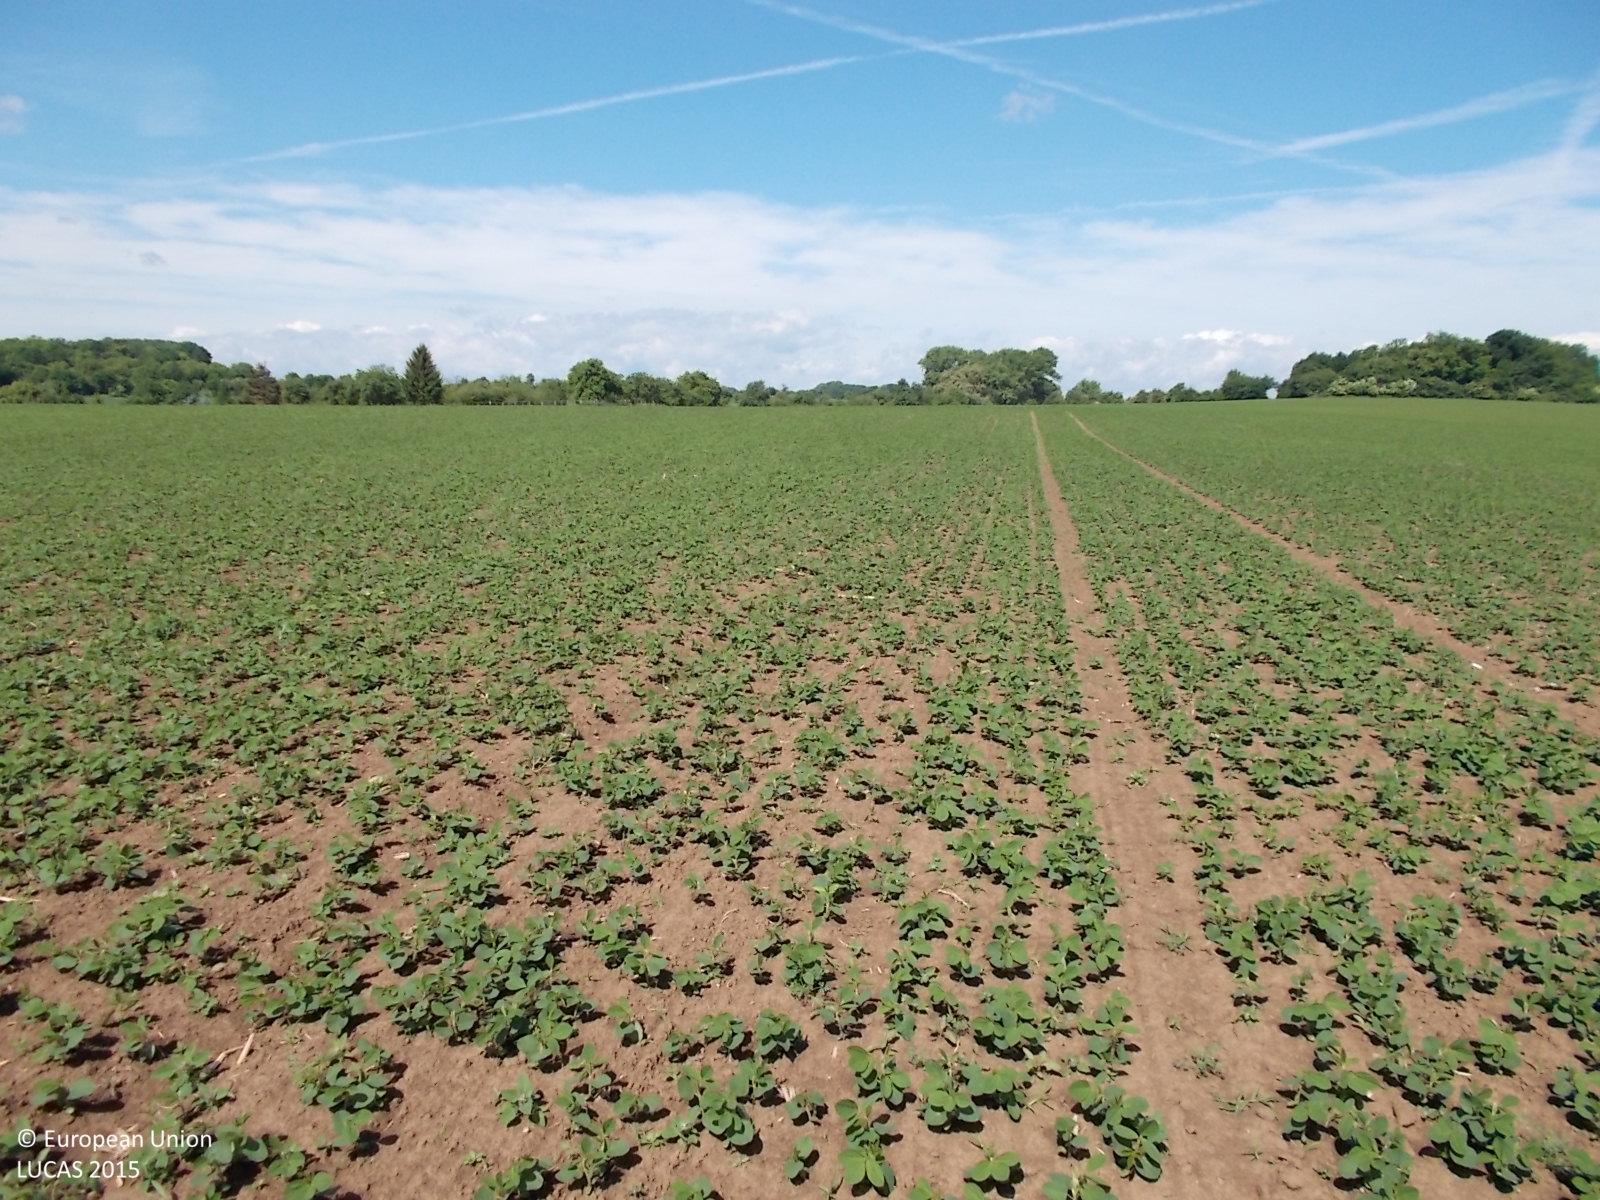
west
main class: Cropland
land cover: Soya
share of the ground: 25 - 50 %
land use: Agriculture (excluding fallow land and kitchen gardens)
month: June
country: CZ
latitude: 50.0137
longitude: 15.1525
